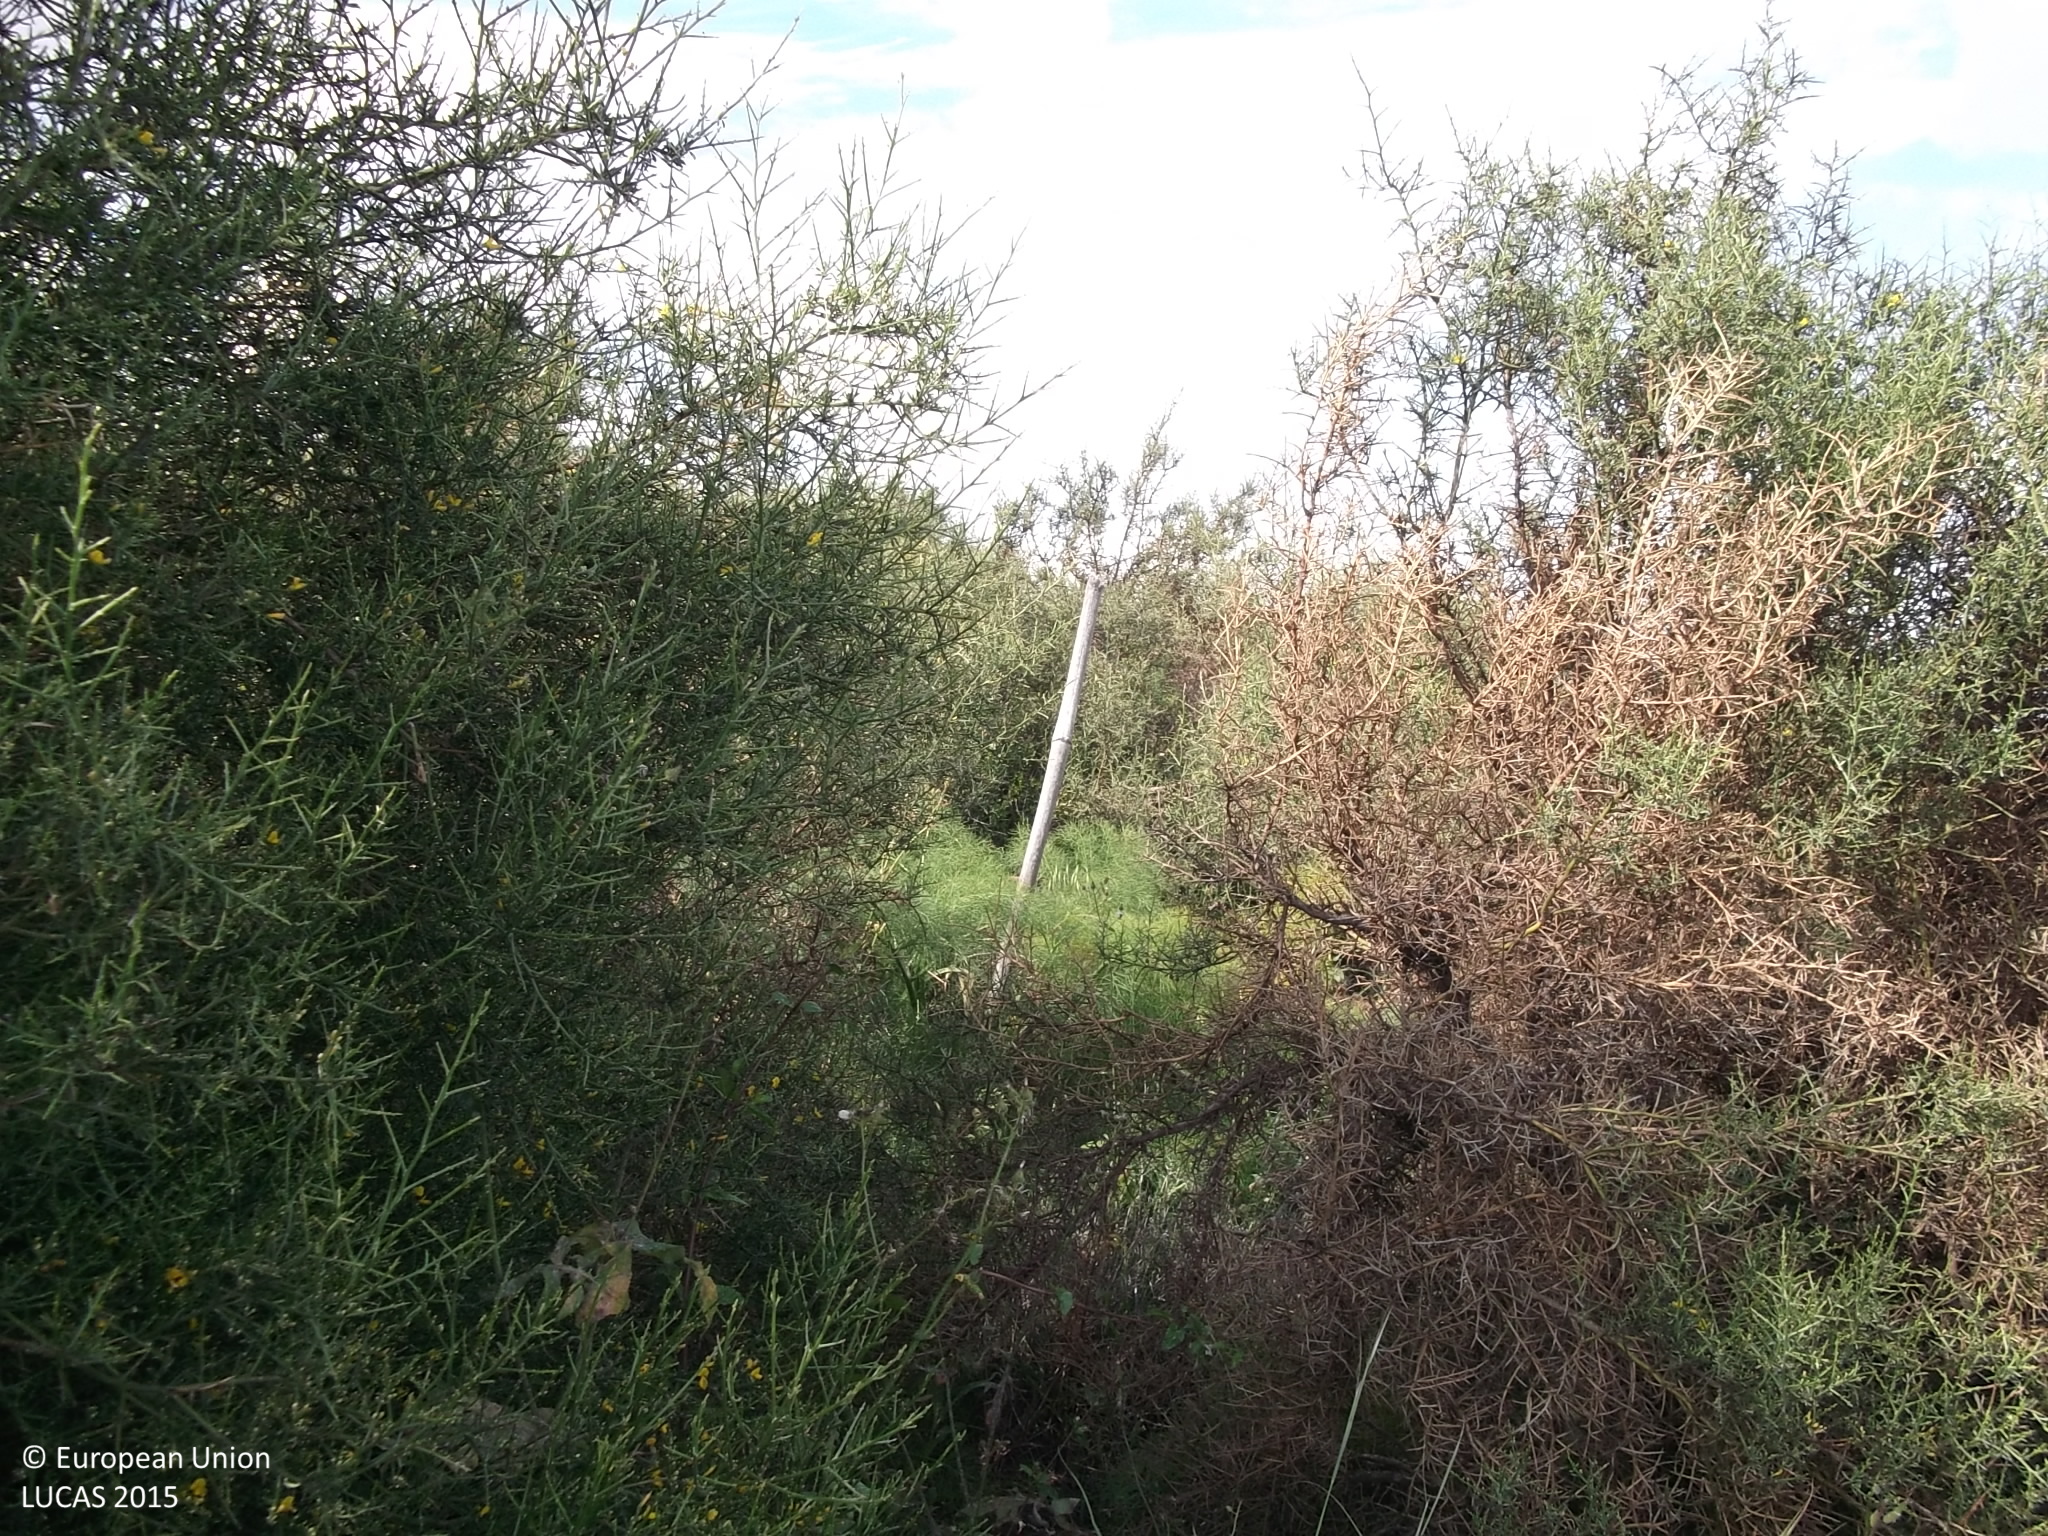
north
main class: Shrubland
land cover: Shrubland without tree cover
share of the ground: 50 - 75 %
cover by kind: shrubs 70 %, herbaceous plants 20 %, unconsolidated bare surface 10 %
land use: Semi-natural and natural areas not in use
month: April
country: CY
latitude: 34.7952
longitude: 33.4313
